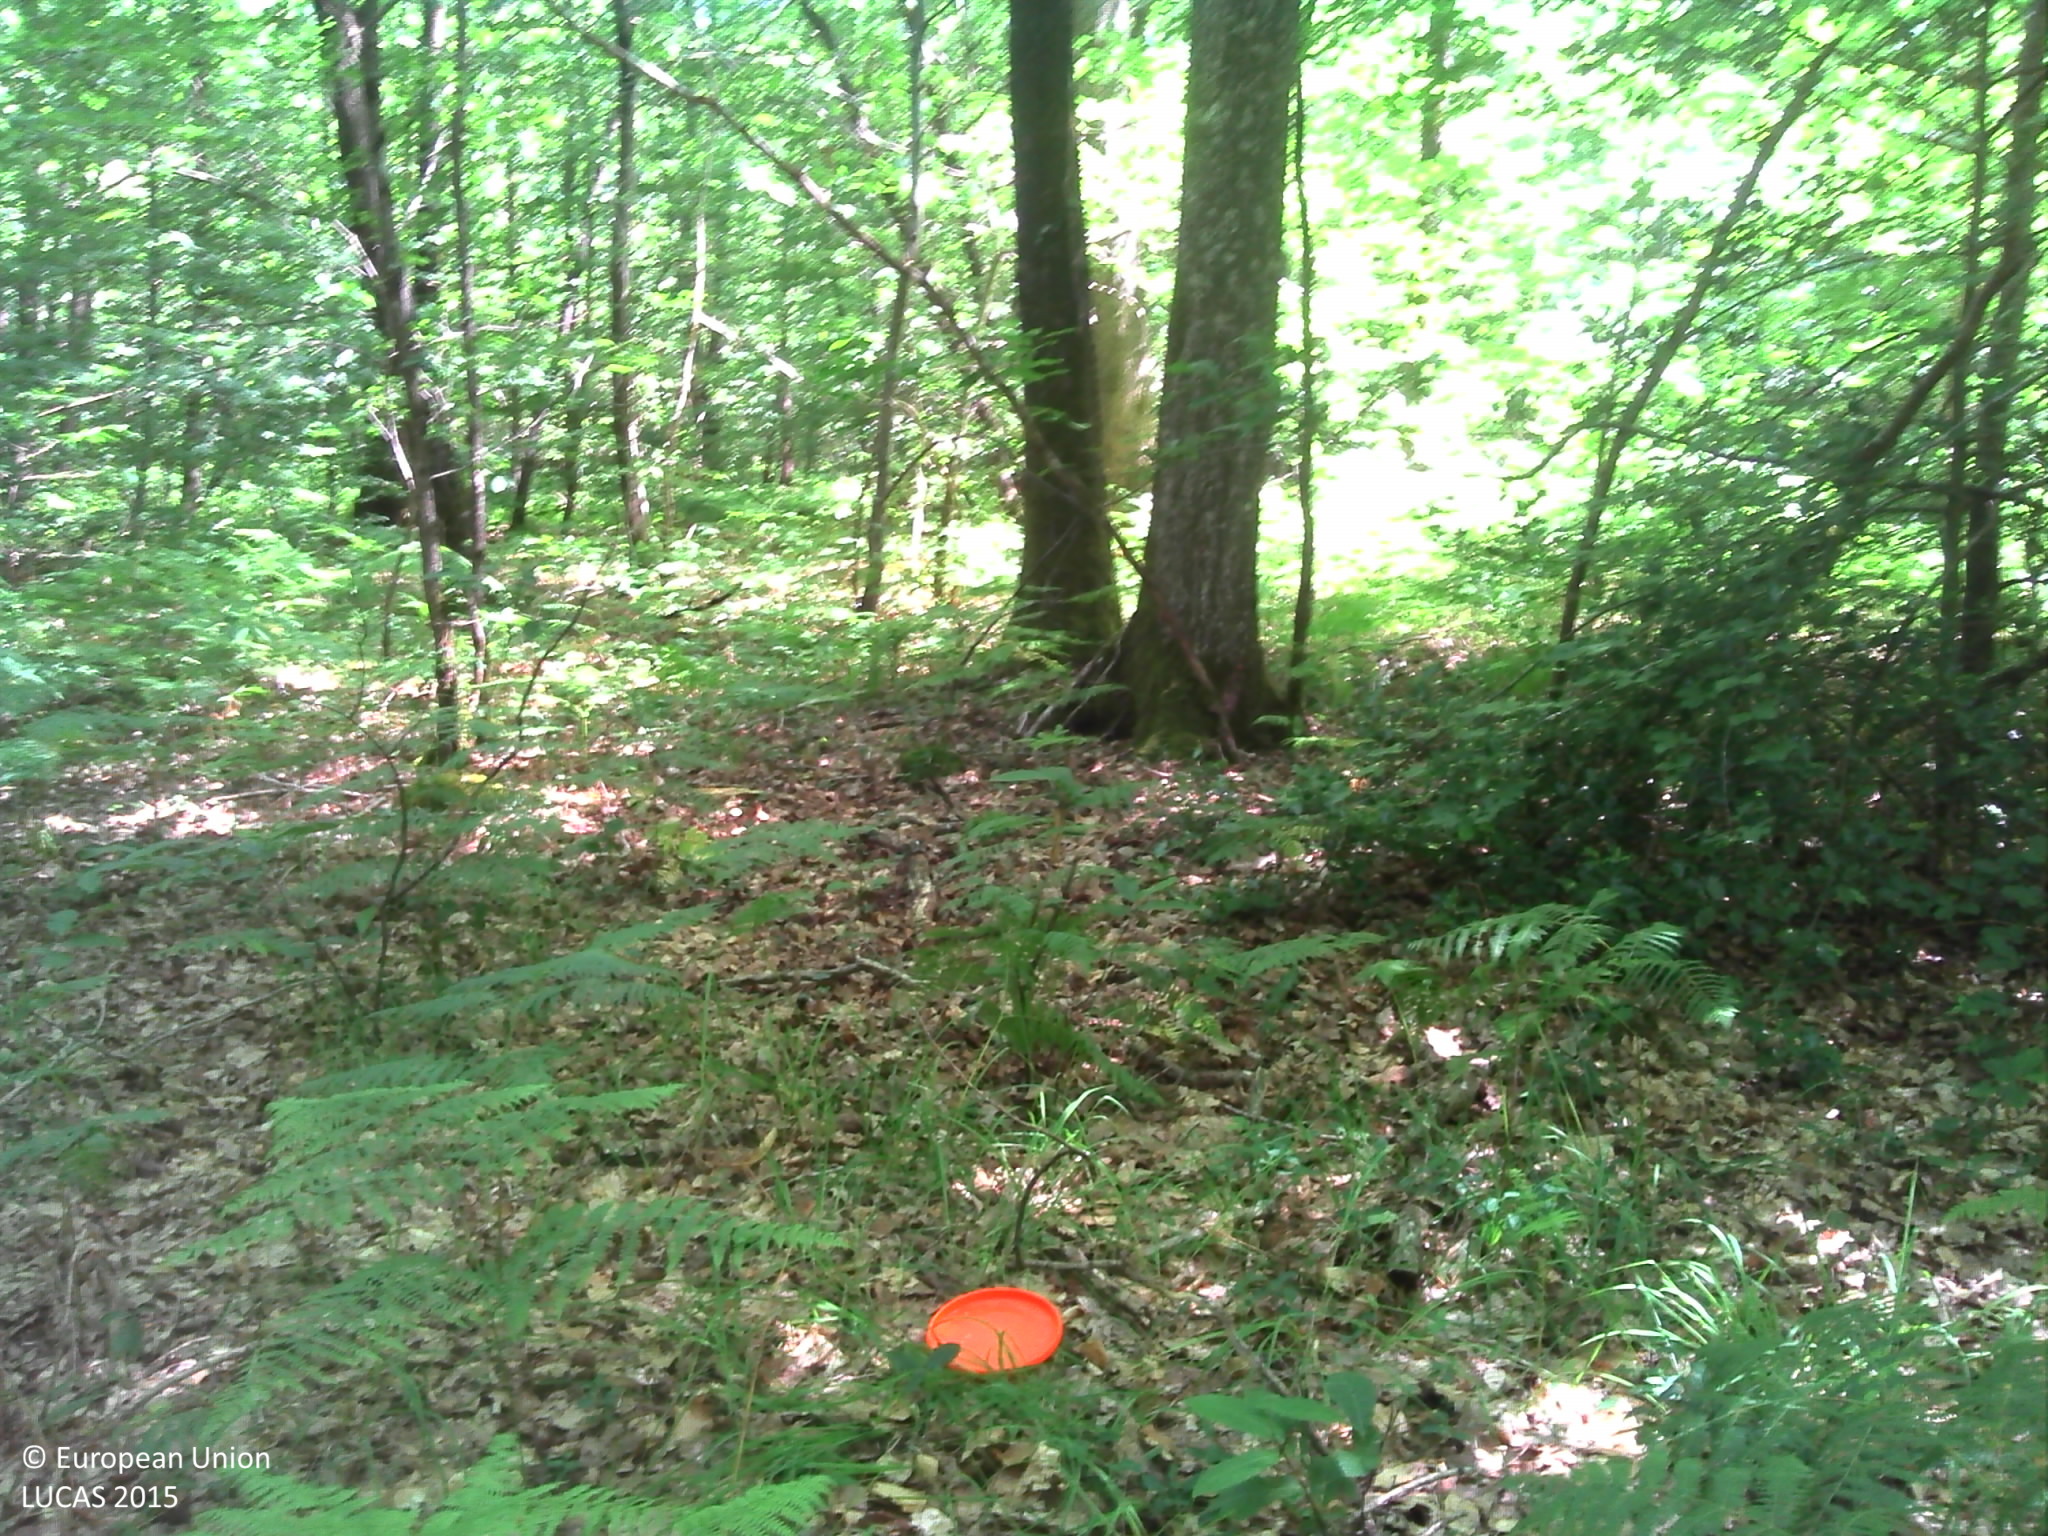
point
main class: Woodland
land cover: Broadleaved woodland
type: mesophytic deciduous forest
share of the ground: > 75 %
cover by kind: broadleaved forest trees 80 %, herbaceous plants 10 %, coniferous forest trees 5 %, lichens and mosses 5 %
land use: Forestry
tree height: > 5 m
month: June
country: FR
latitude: 47.5474
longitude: 0.3706
